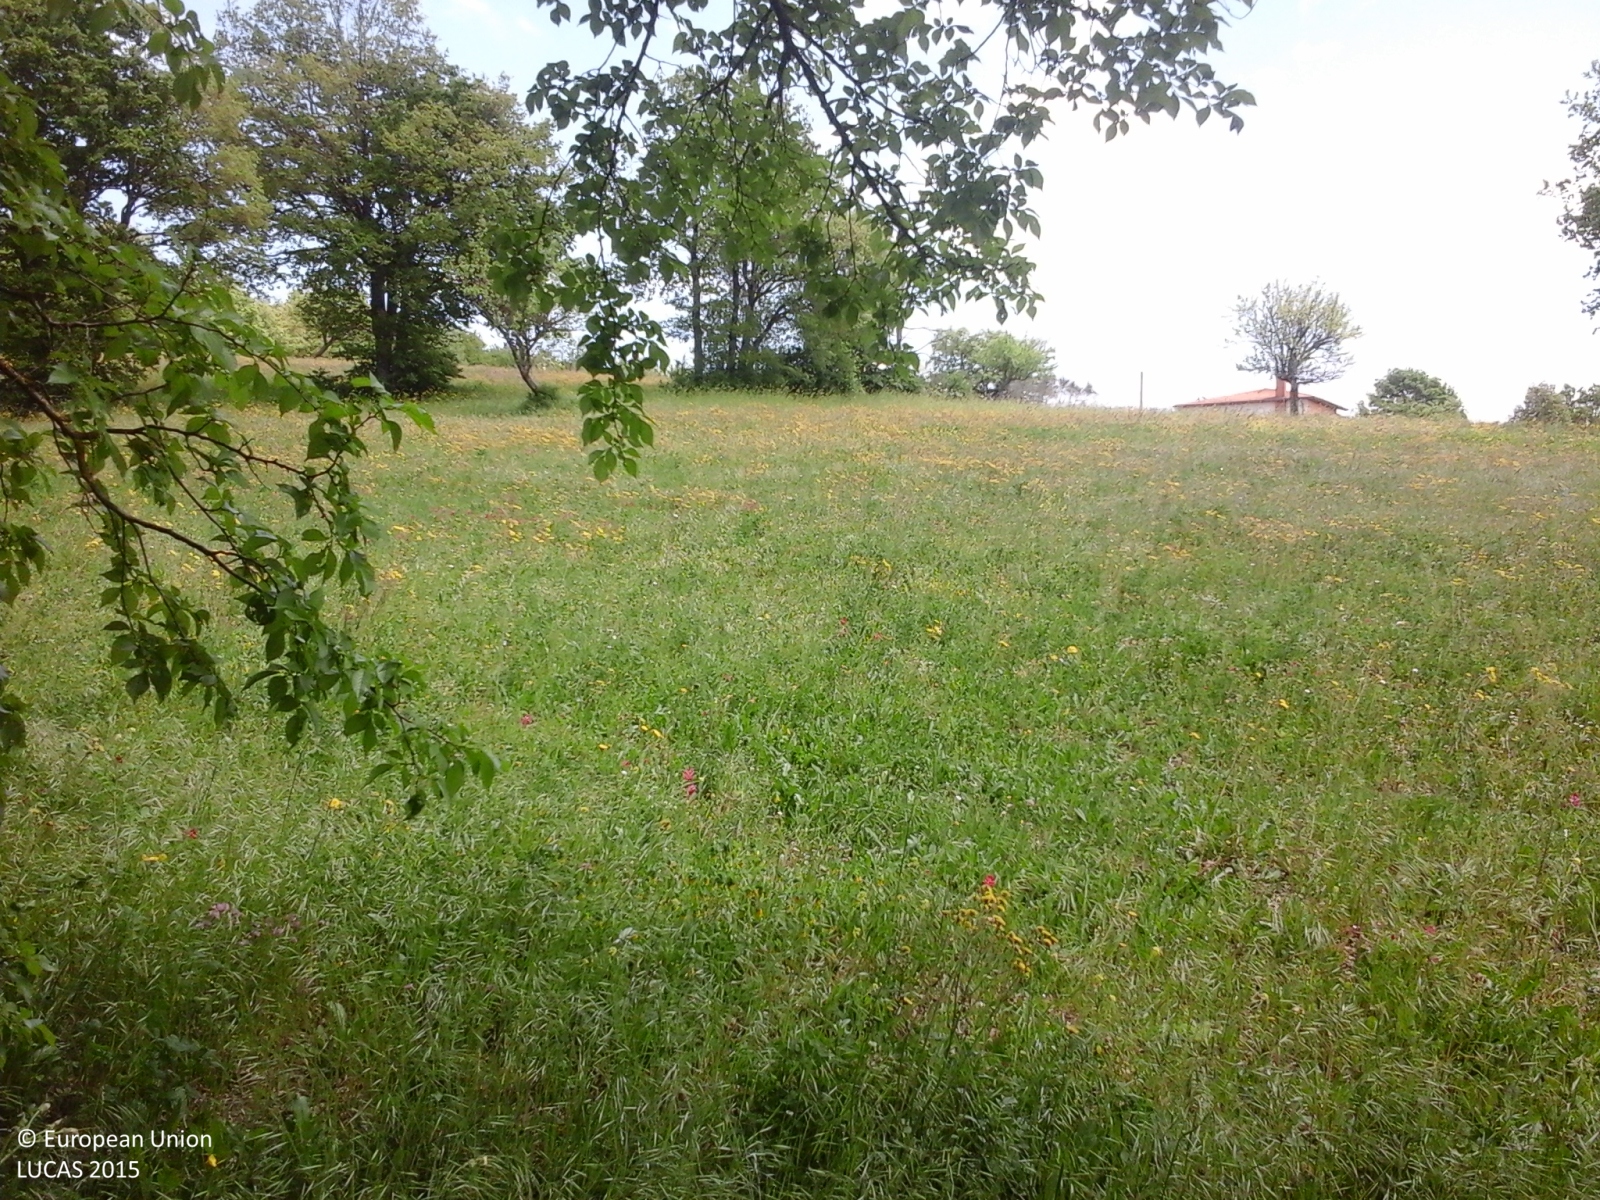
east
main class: Woodland
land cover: Broadleaved woodland
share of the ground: > 75 %
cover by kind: broadleaved forest trees 80 %, shrubs 20 %
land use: Forestry
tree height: > 5 m
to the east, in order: Broadleaved woodland; Rock outcrops; Ditches and canals; Broadleaved woodland; Grassland with sparse tree/shrub cover; Ditches and canals; Common wheat; Tracks; Vineyards; Spontaneously vegetated surfaces; Artificial constructions in urban areas; Spontaneously vegetated surfaces; Artificial constructions in urban areas; Broadleaved woodland; Arable land (only in case pi); Broadleaved woodland
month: May
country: IT
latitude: 41.3864
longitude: 14.7067
